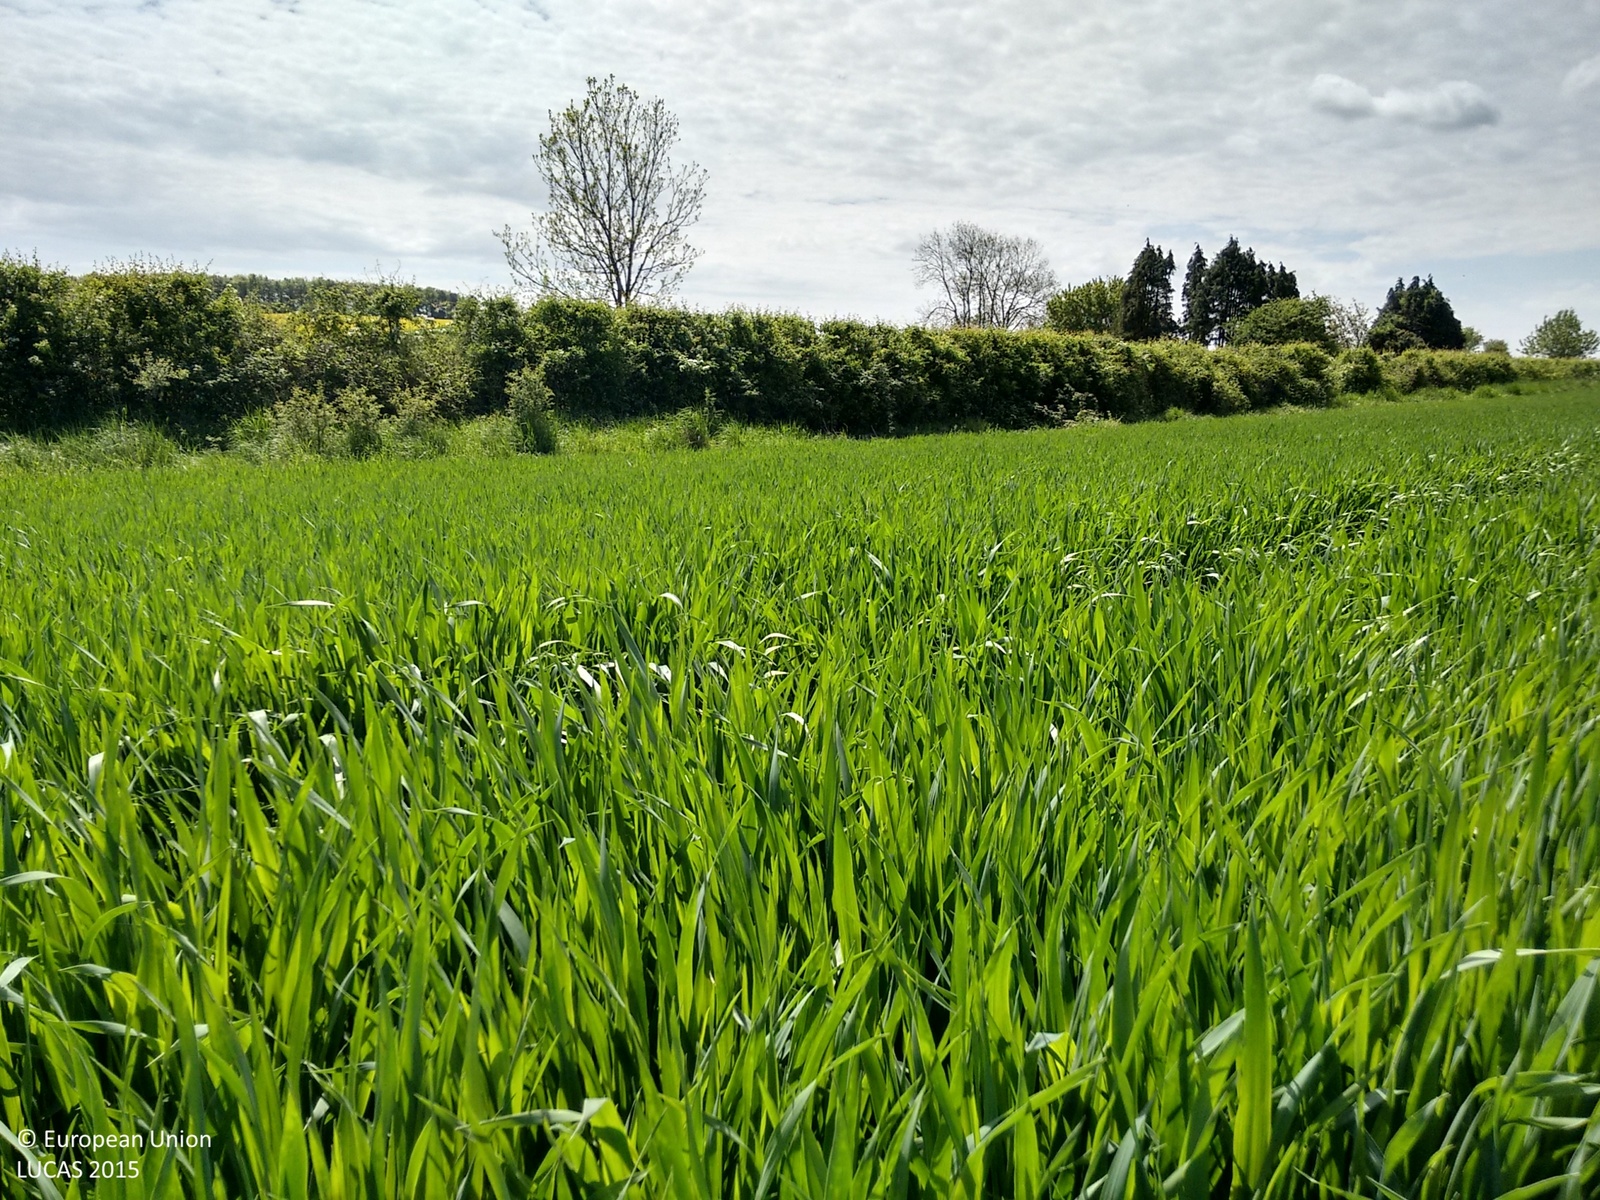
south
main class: Cropland
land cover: Common wheat
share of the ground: > 75 %
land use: Agriculture (excluding fallow land and kitchen gardens)
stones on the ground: > 50 %
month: May
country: GB
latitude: 50.9036
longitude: -2.0755
